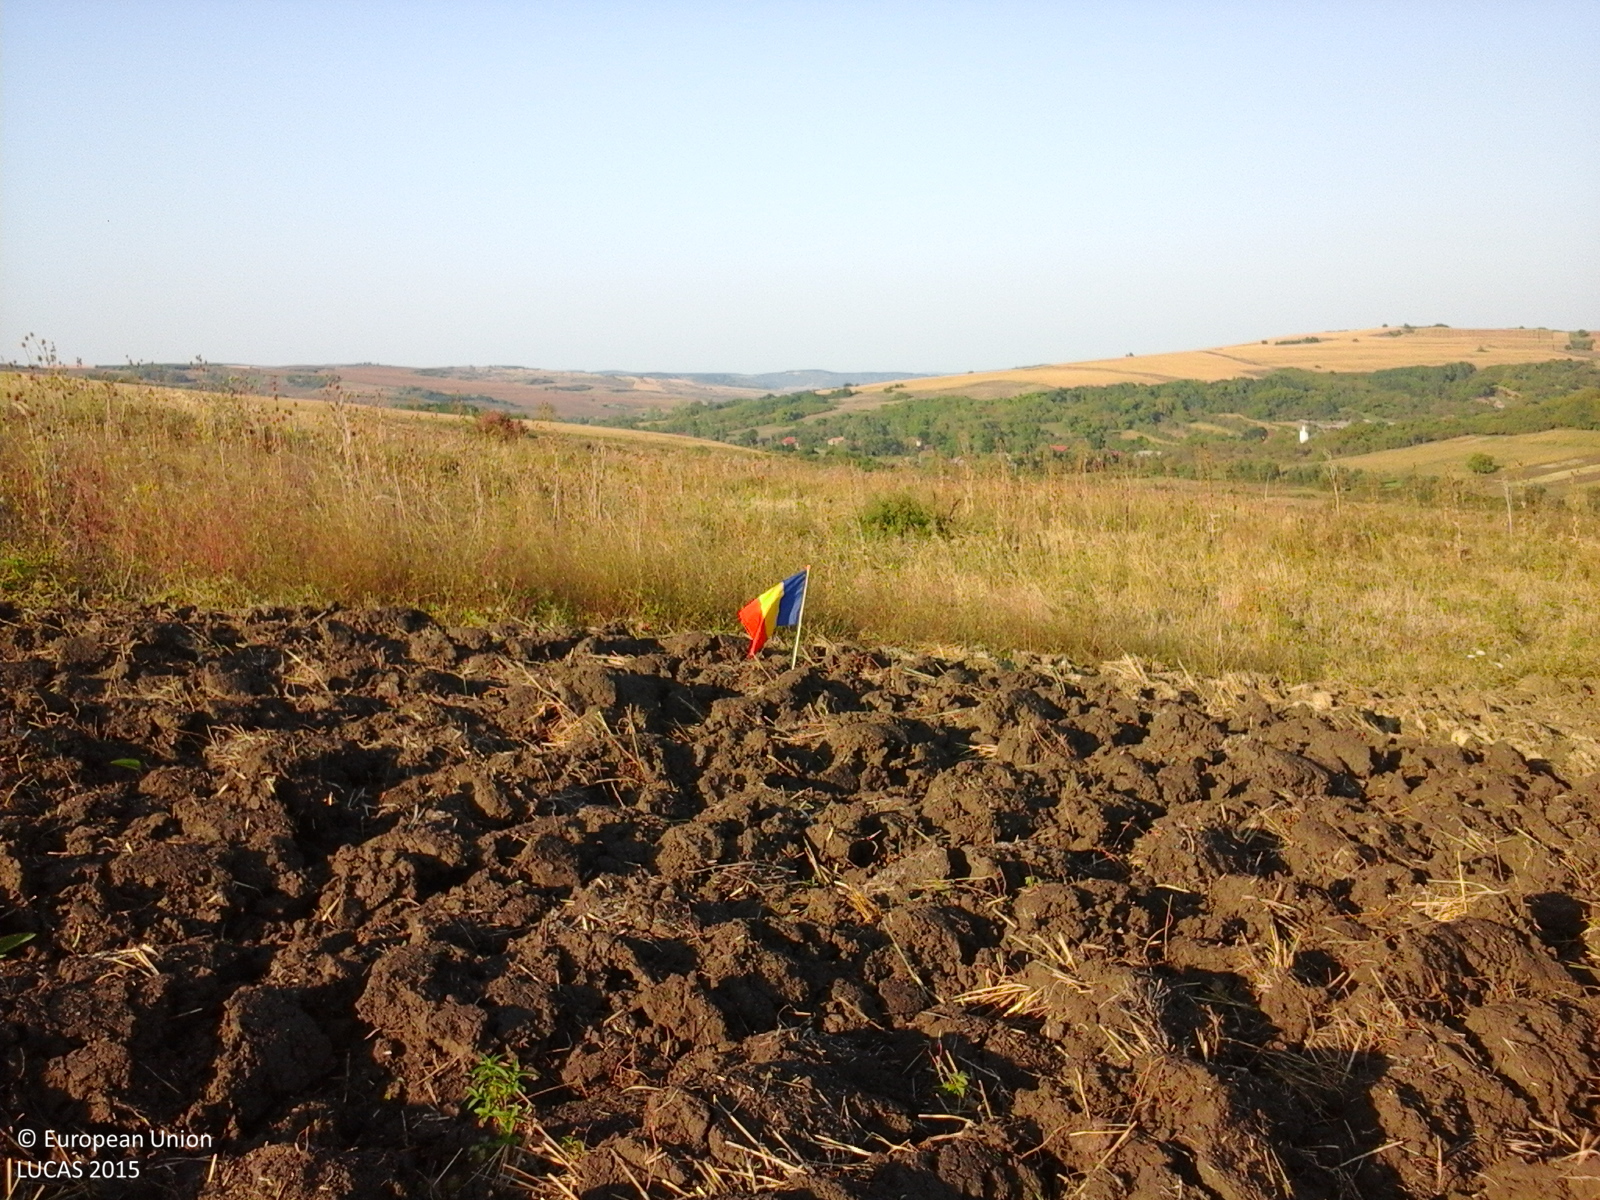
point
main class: Cropland
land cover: Oats
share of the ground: < 10 %
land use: Agriculture (excluding fallow land and kitchen gardens)
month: September
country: RO
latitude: 47.2994
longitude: 23.0383
